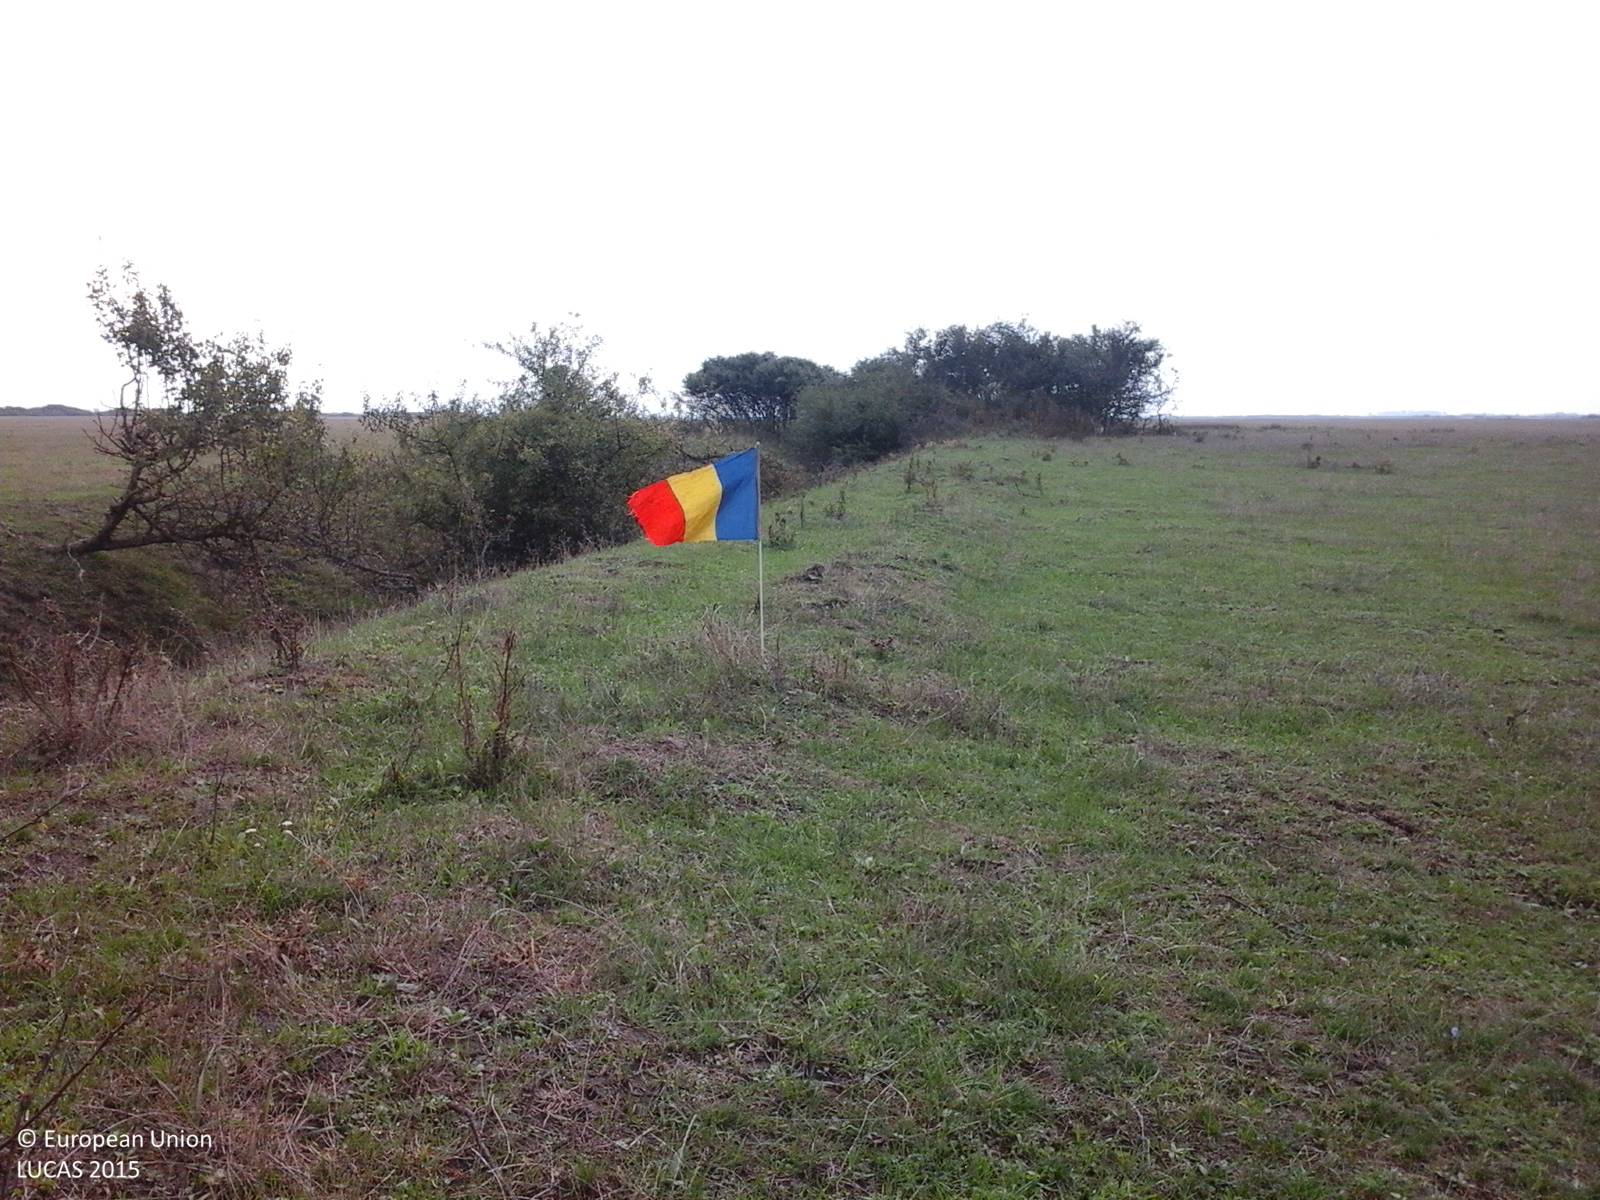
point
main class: Grassland
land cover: Grassland without tree/shrub cover
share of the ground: > 75 %
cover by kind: herbaceous plants 100 %
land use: Agriculture (excluding fallow land and kitchen gardens)
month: September
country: RO
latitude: 46.6756
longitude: 21.8210
